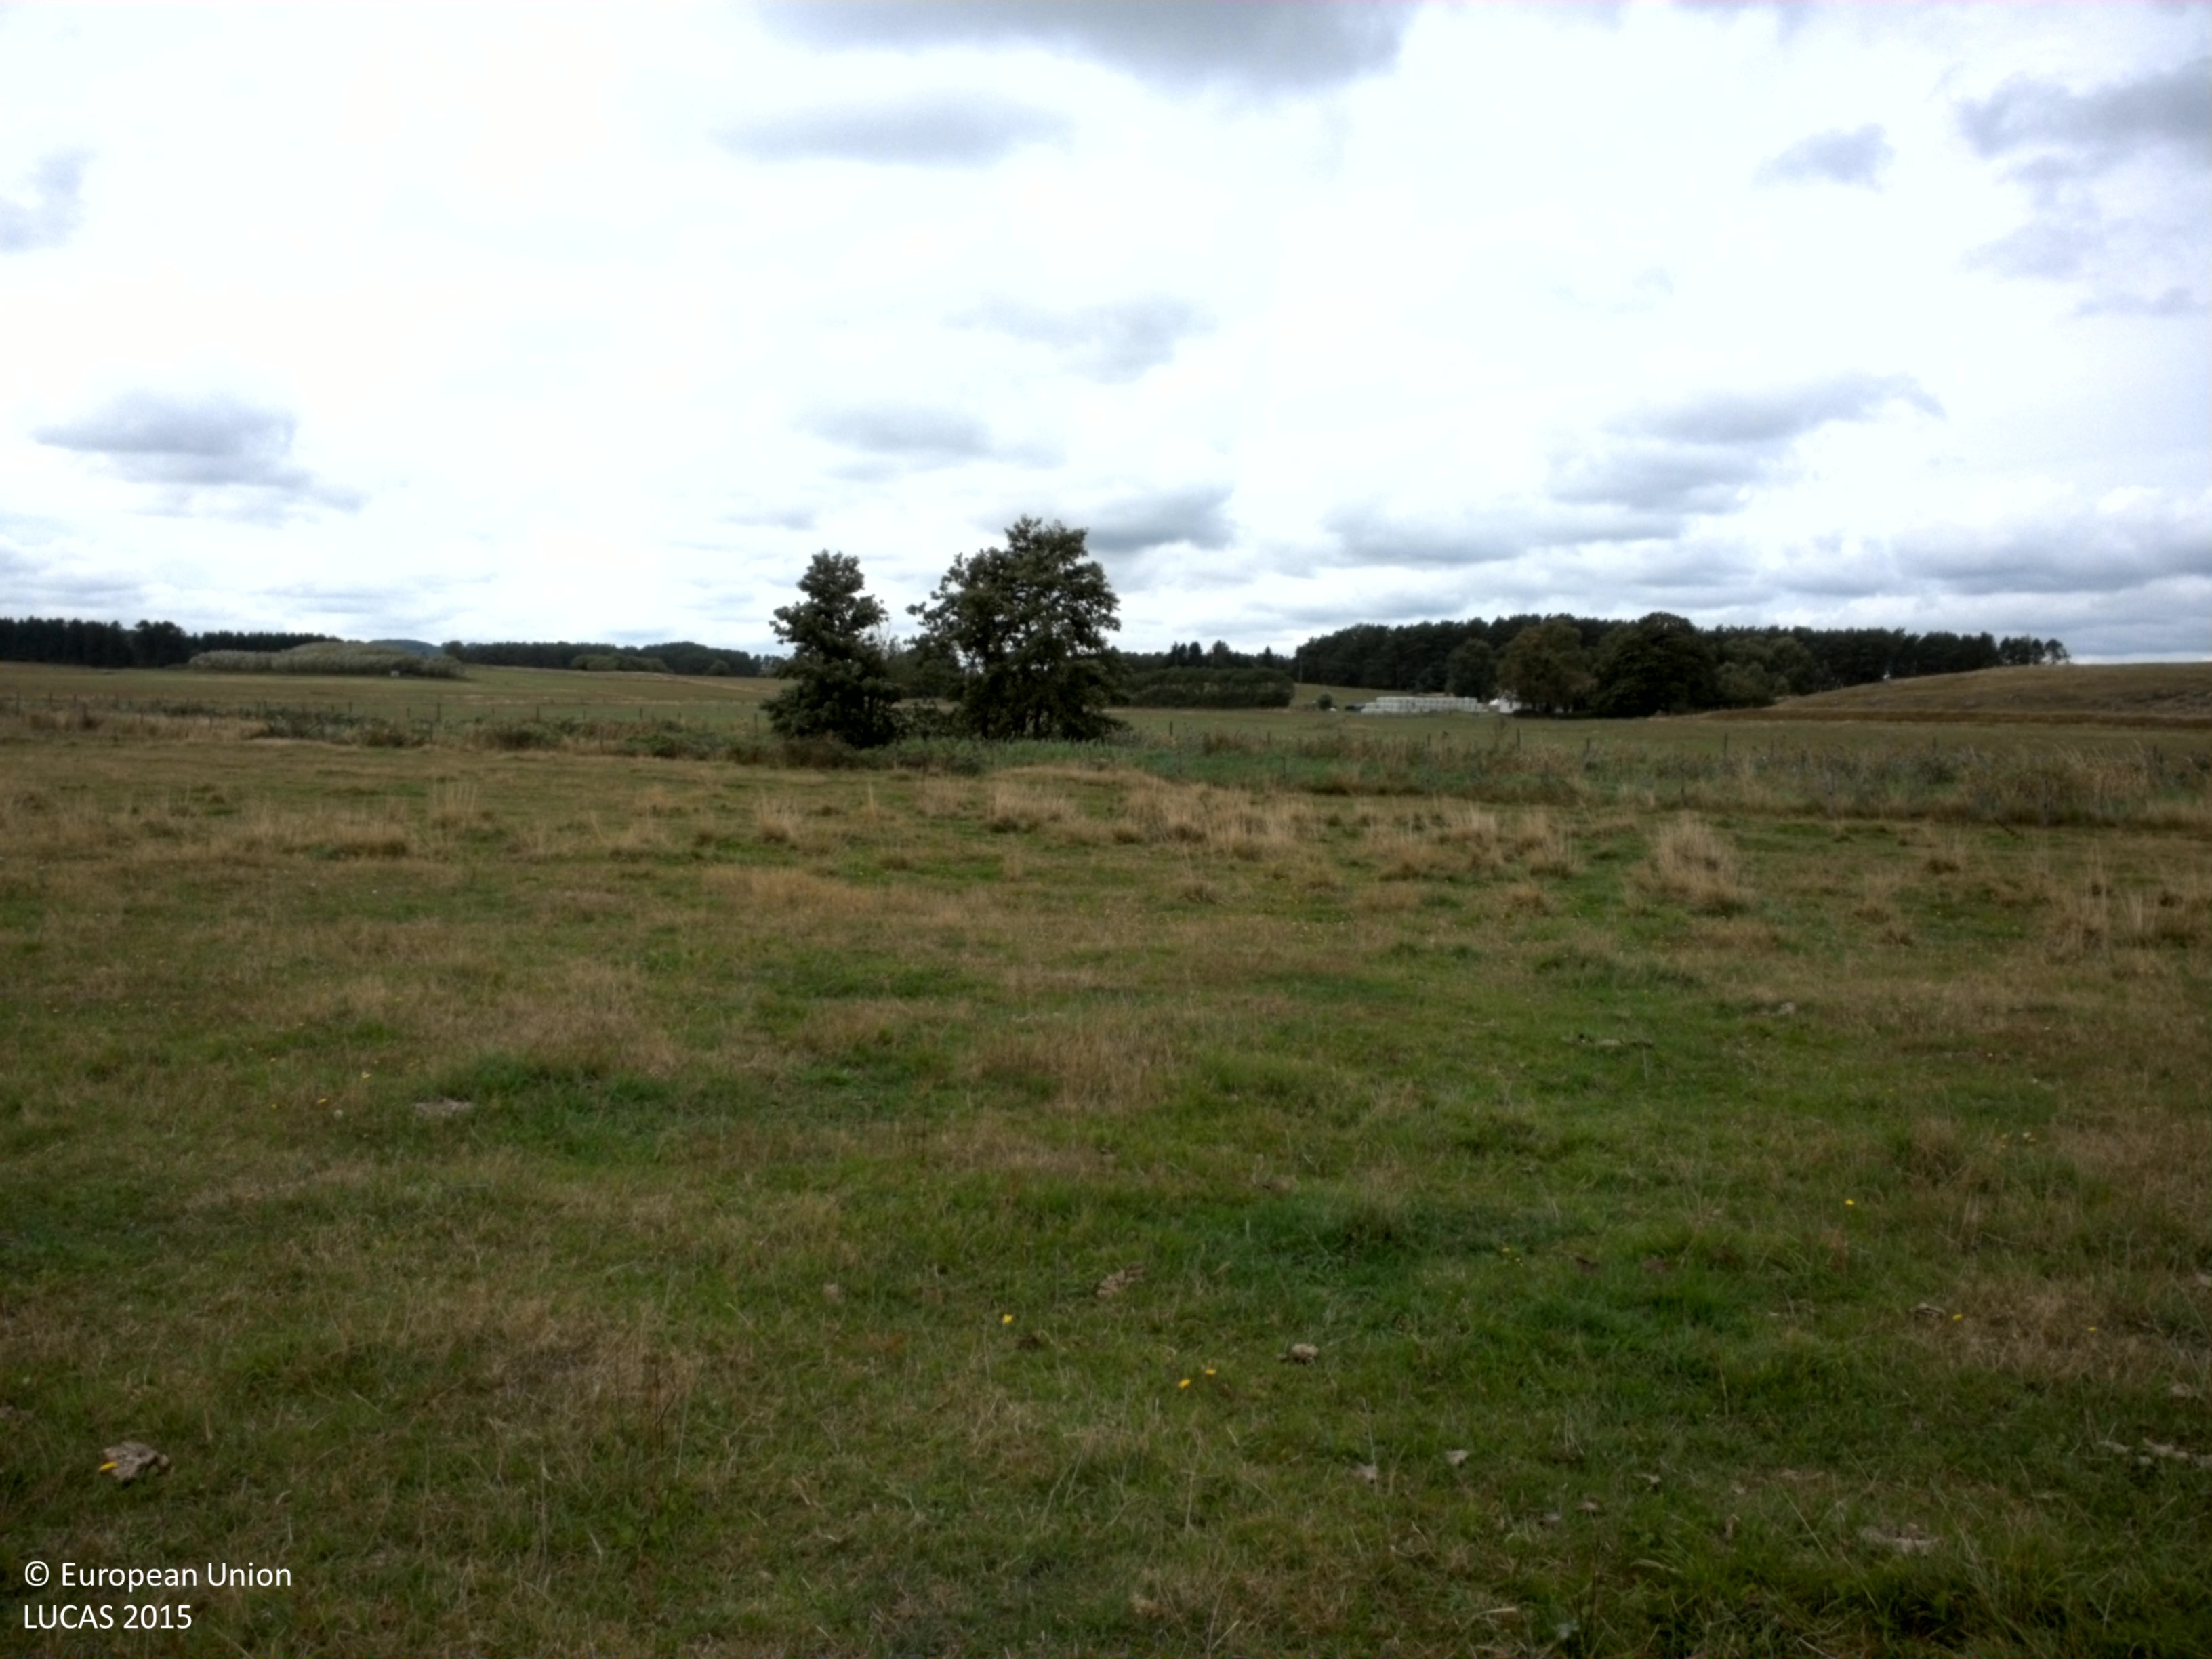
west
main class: Grassland
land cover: Grassland without tree/shrub cover
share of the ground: > 75 %
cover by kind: herbaceous plants 100 %
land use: Agriculture (excluding fallow land and kitchen gardens)
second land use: Amenities, museums, leisure
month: September
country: SE
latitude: 55.5598
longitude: 13.6607
